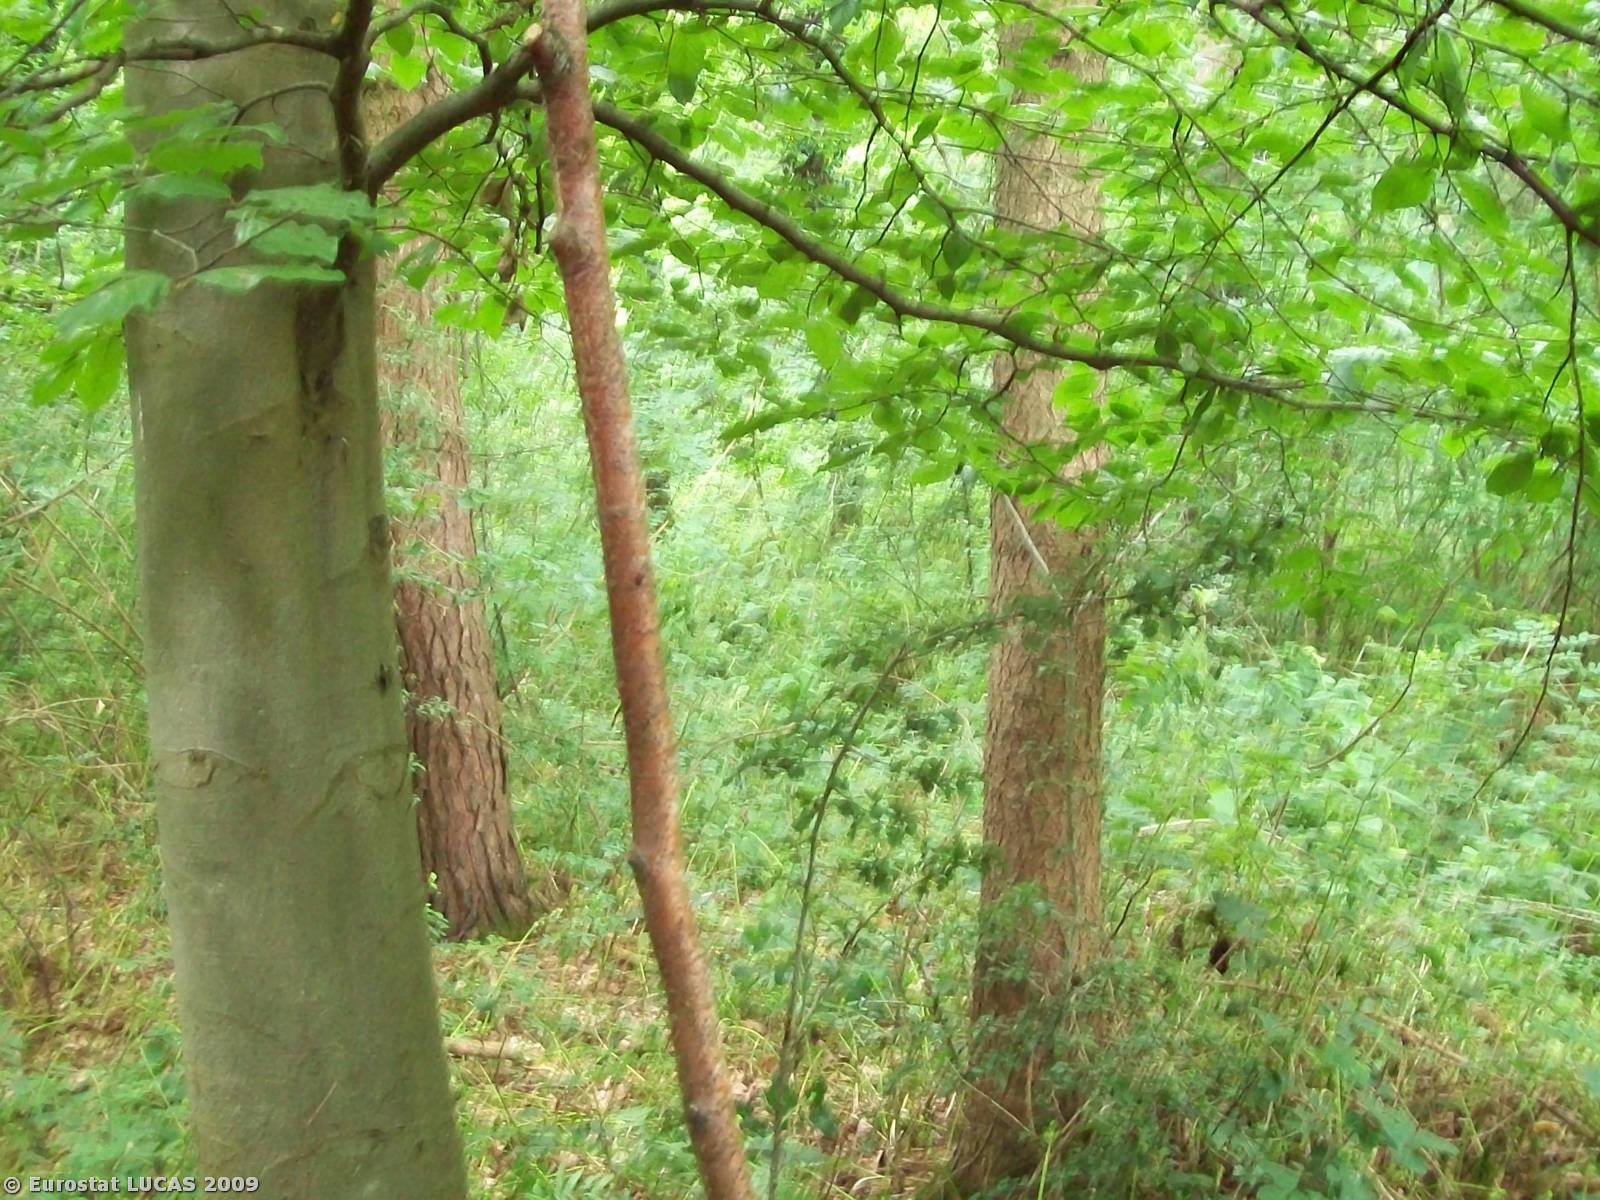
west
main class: Woodland
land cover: Broadleaved woodland
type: mesophytic deciduous forest
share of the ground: > 75 %
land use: Forestry
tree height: > 5 m
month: June
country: GB
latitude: 51.3429
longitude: -2.2215
